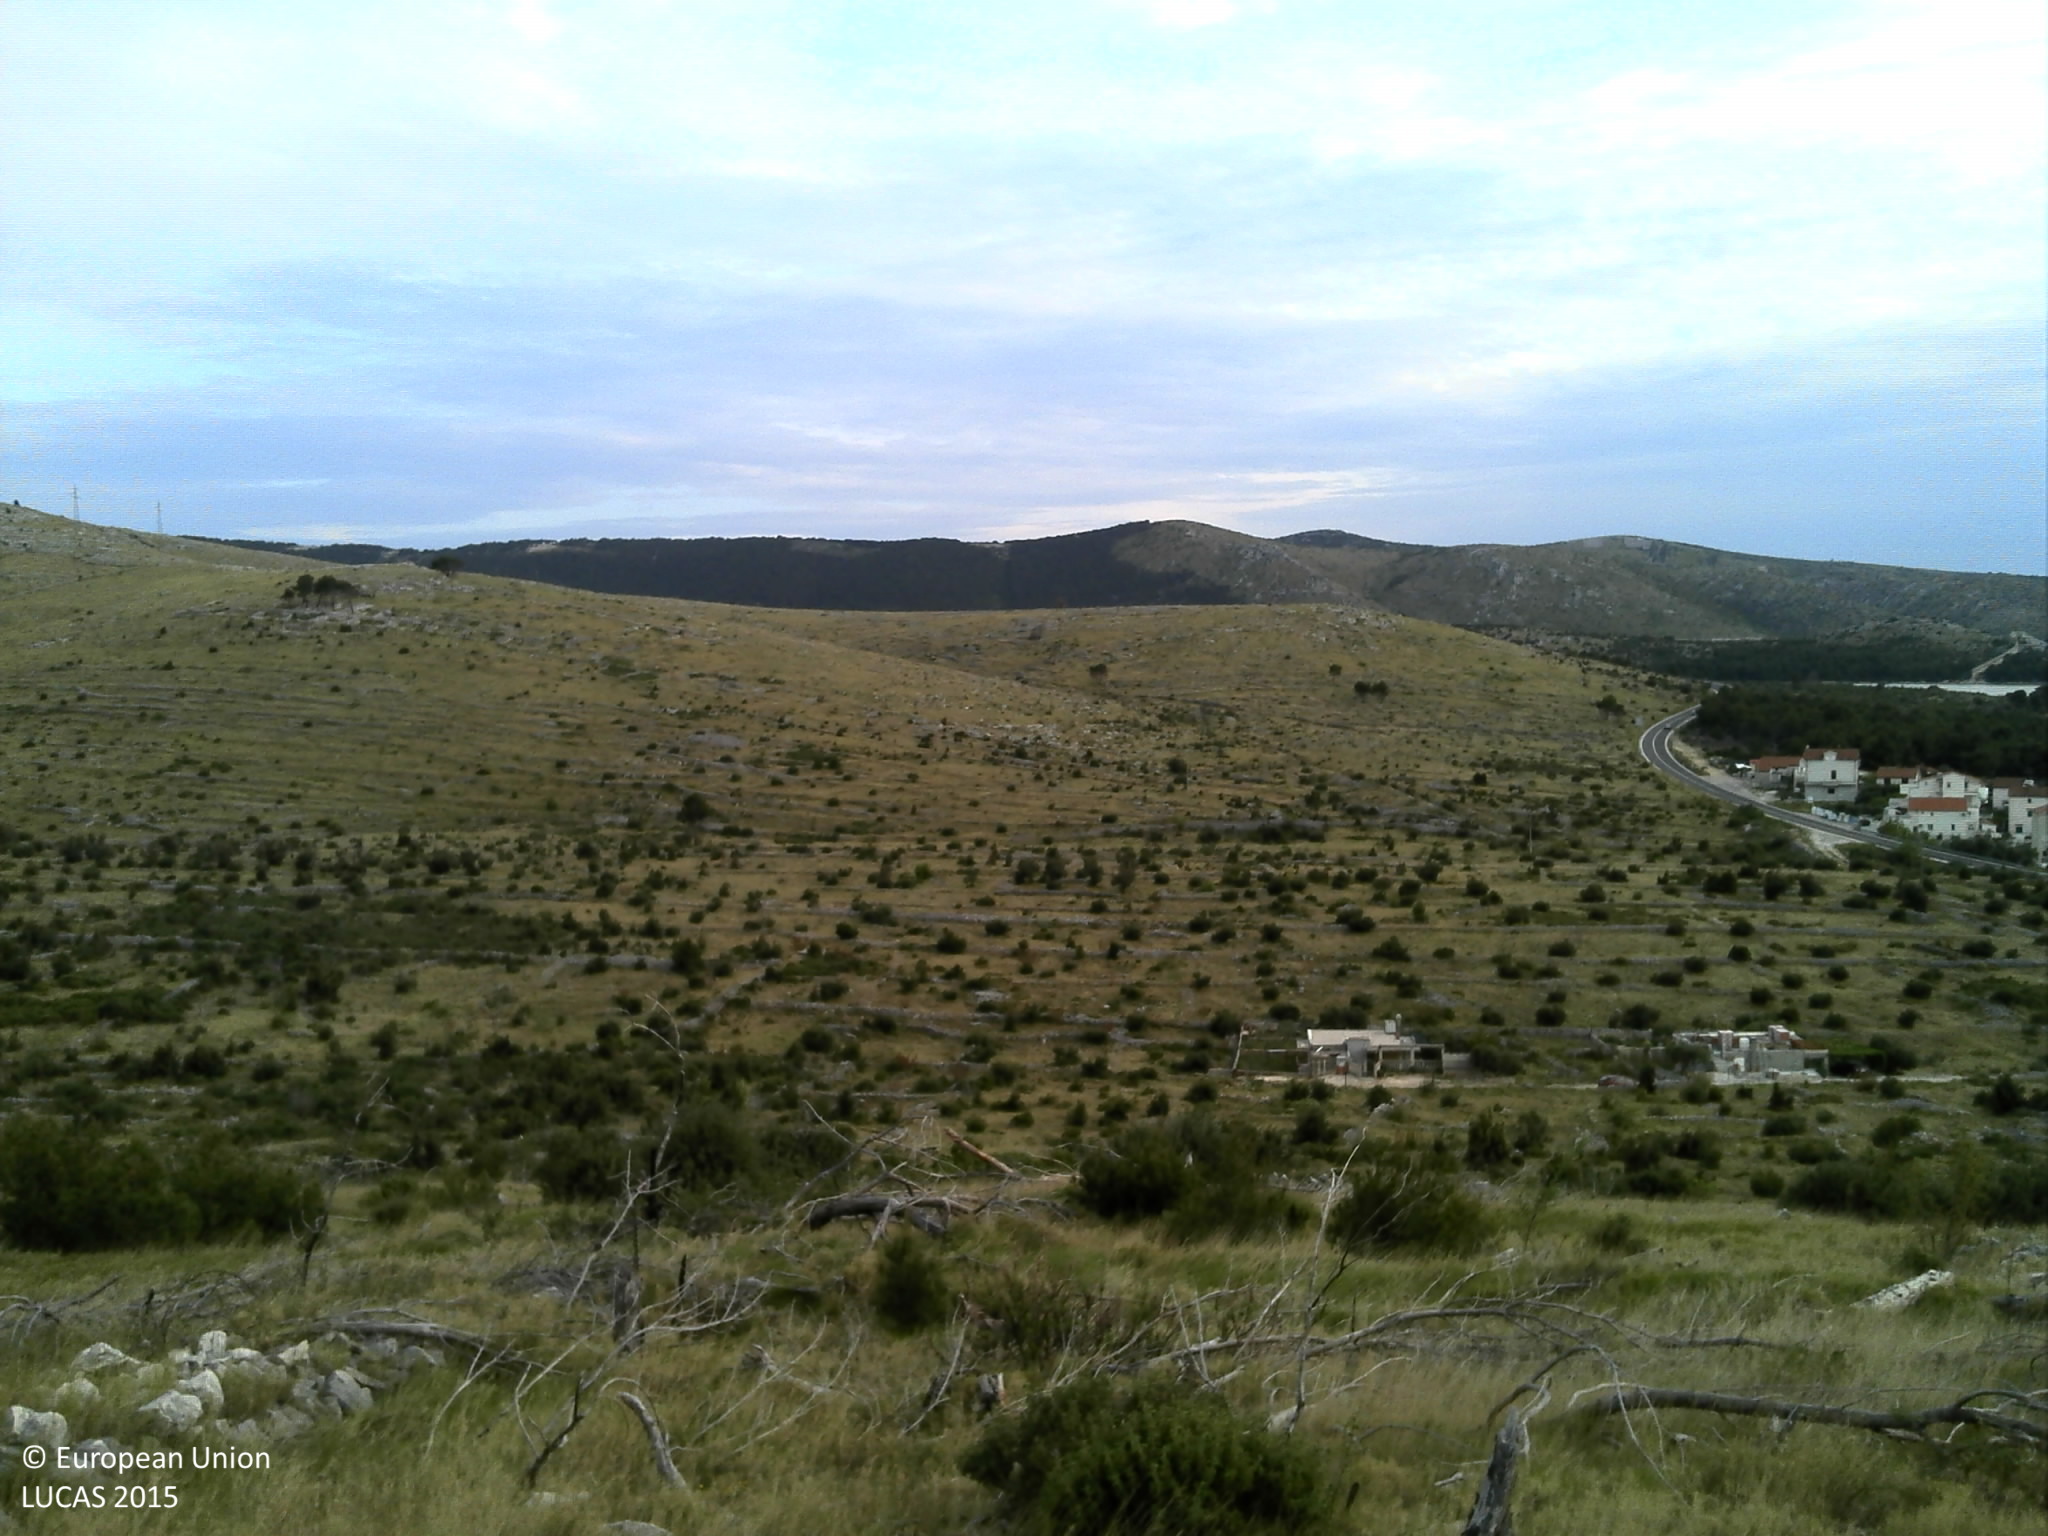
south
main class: Grassland
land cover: Grassland with sparse tree/shrub cover
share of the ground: > 75 %
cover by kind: herbaceous plants 65 %, shrubs 10 %, consolidated bare surface 10 %, unconsolidated bare surface 10 %, coniferous forest trees 5 %
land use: Abandoned areas
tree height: < 5 m
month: April
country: HR
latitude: 43.6551
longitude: 15.9549
